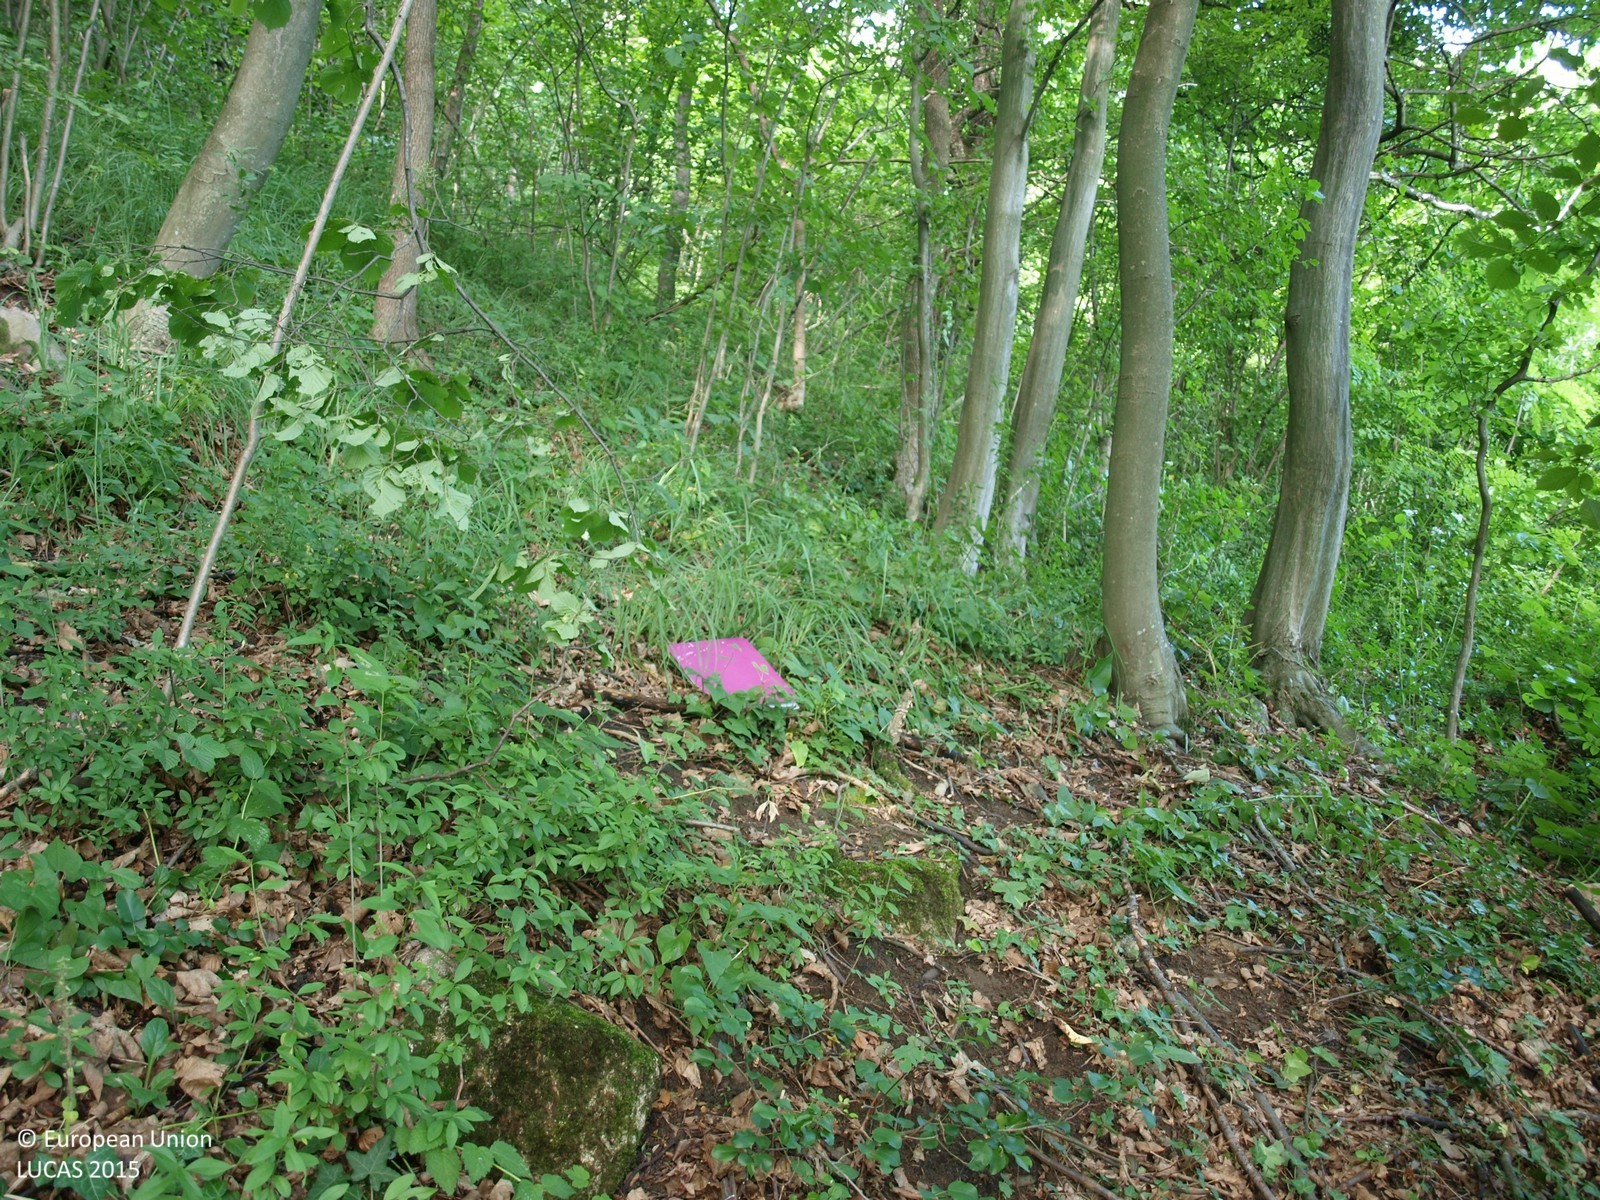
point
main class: Woodland
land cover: Broadleaved woodland
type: mesophytic deciduous forest
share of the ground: > 75 %
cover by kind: broadleaved forest trees 100 %
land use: Forestry
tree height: > 5 m
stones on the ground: < 10 %
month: June
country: HR
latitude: 46.1768
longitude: 16.4121
